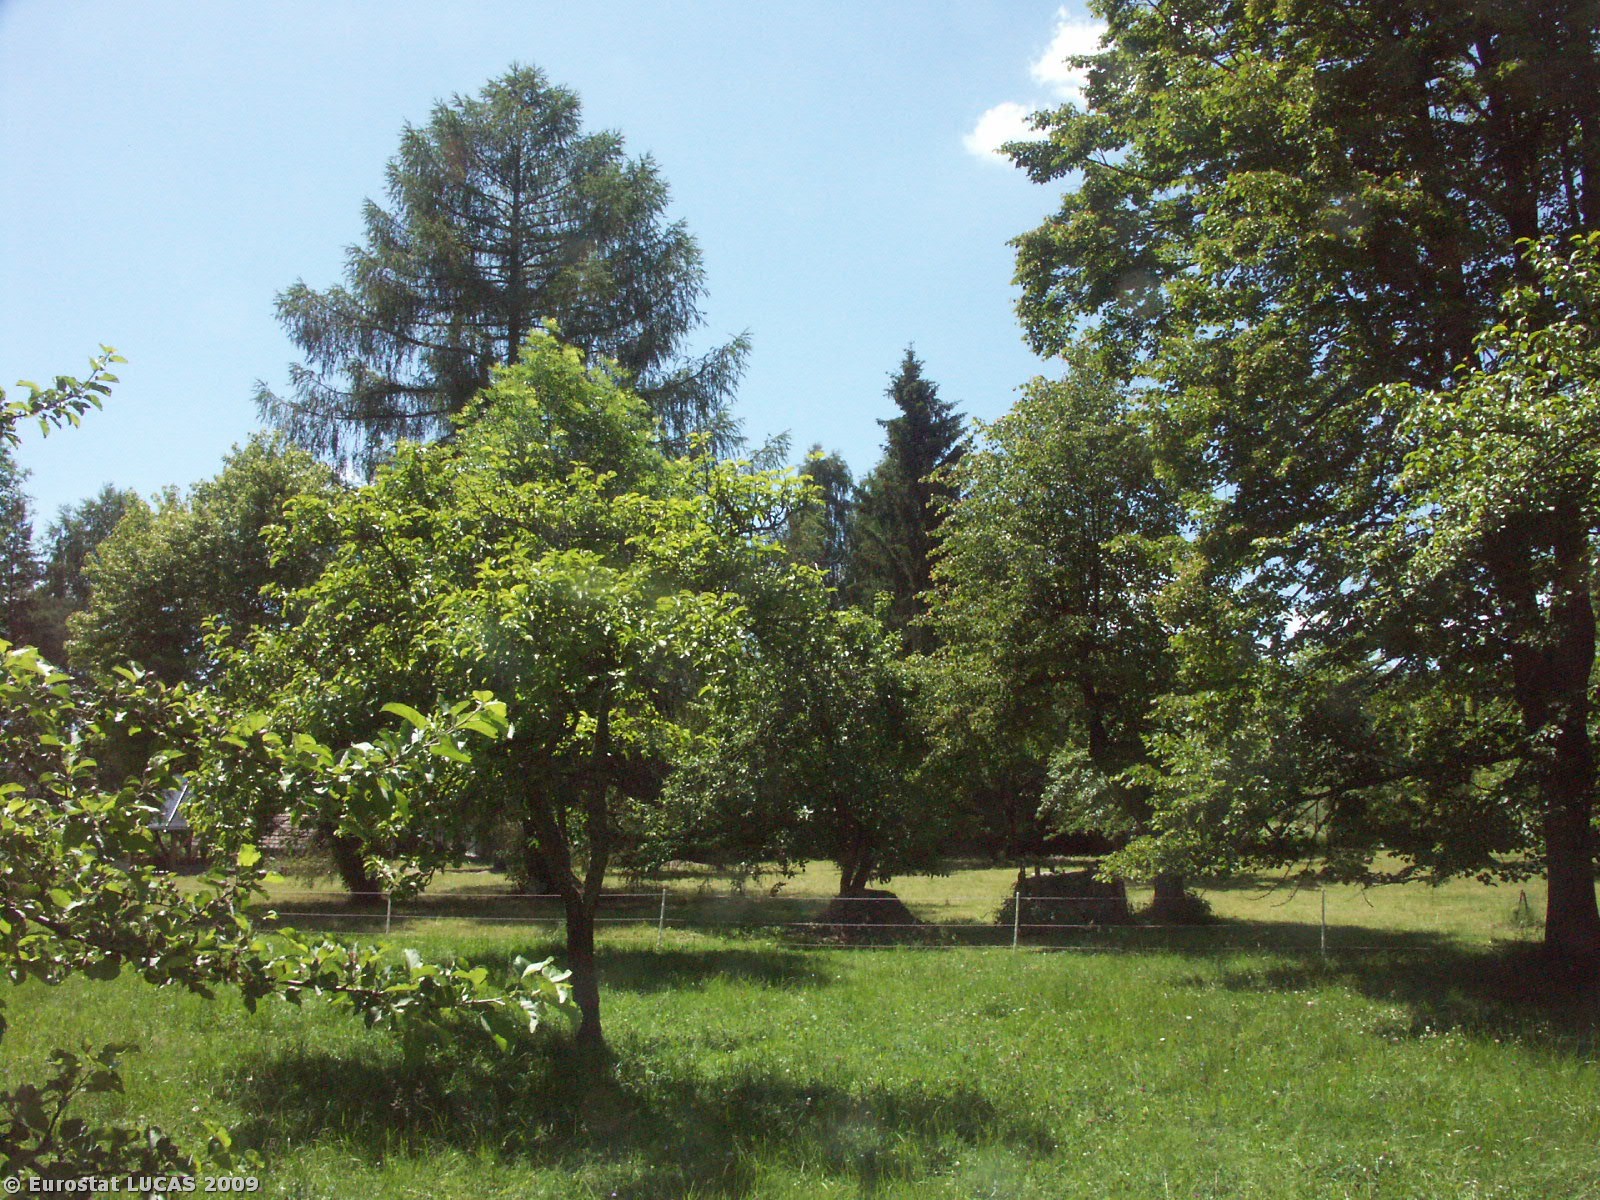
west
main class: Cropland
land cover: Apple fruit
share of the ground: 25 - 50 %
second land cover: Grassland with sparse tree/shrub cover
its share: > 75 %
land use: Kitchen garden
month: June
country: CZ
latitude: 48.7780
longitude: 14.0965
